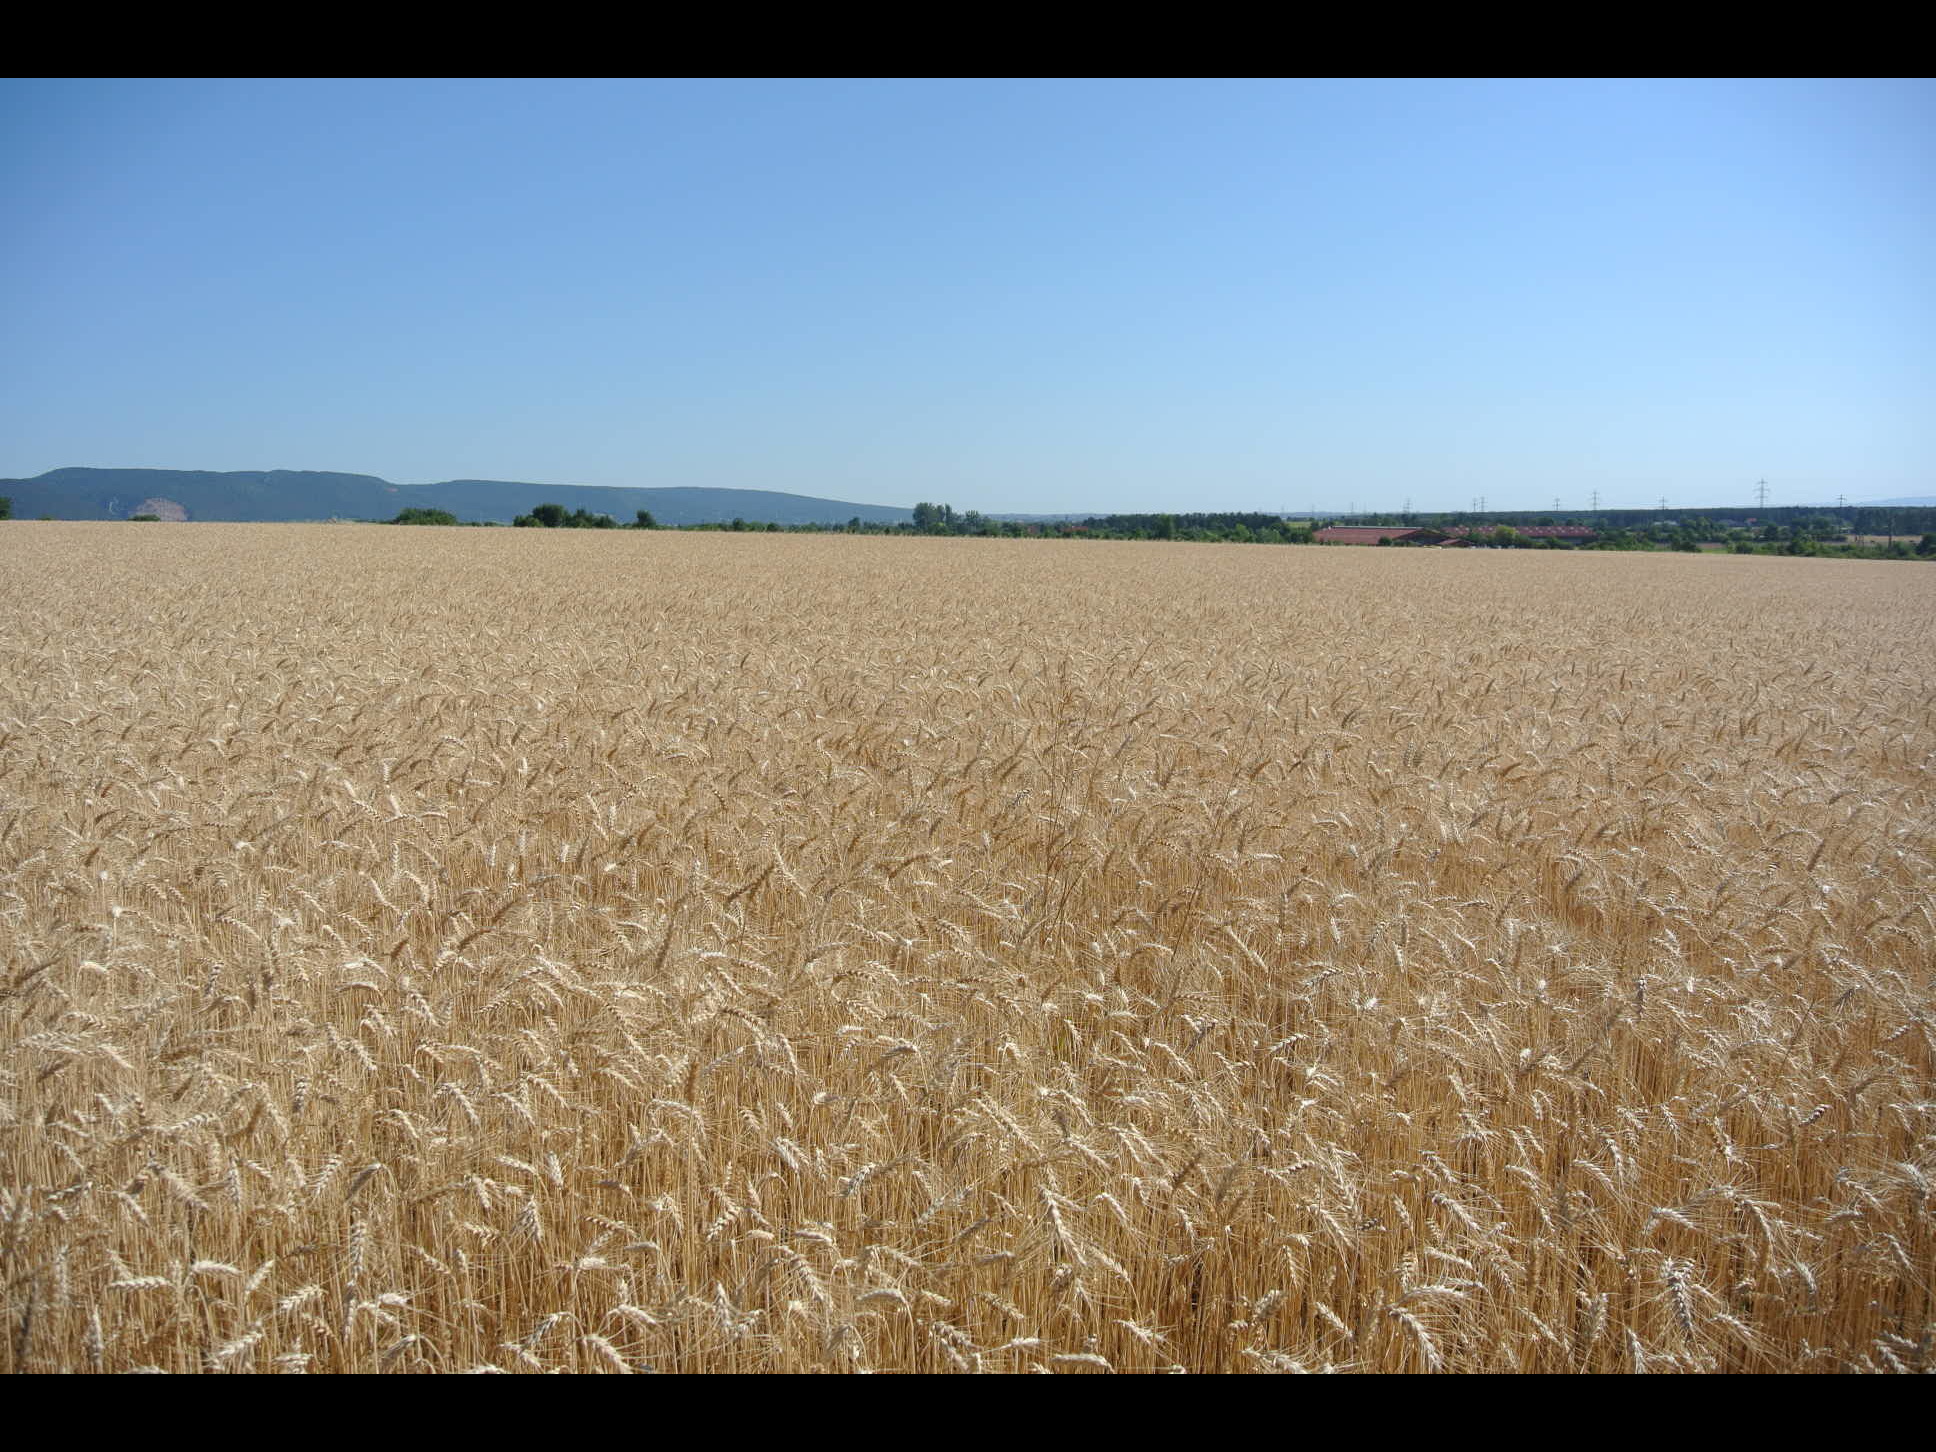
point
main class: Cropland
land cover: Durum wheat
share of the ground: > 75 %
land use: Agriculture (excluding fallow land and kitchen gardens)
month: July
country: AT
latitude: 47.7658
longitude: 16.1006
